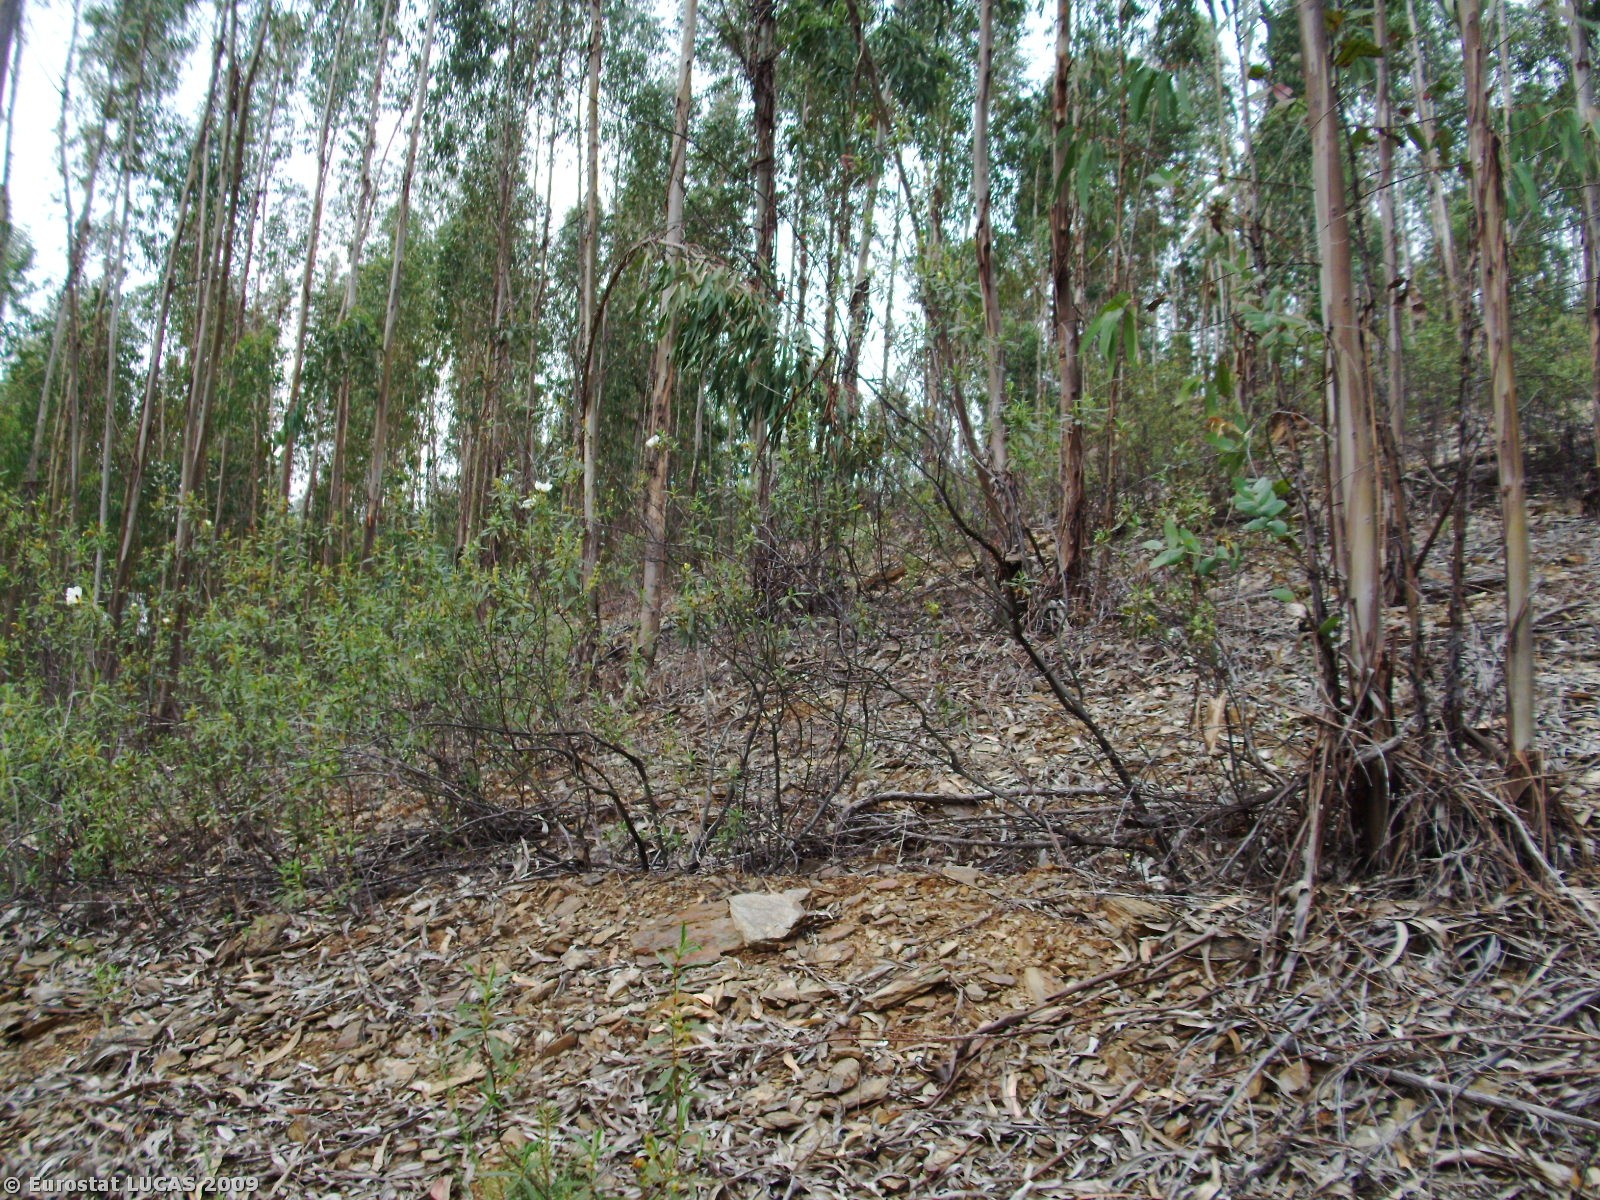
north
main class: Woodland
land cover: Broadleaved woodland
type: plantations and self-sown exotic forest
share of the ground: > 75 %
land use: Forestry
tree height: > 5 m
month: April
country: PT
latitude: 39.7648
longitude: -7.5271
